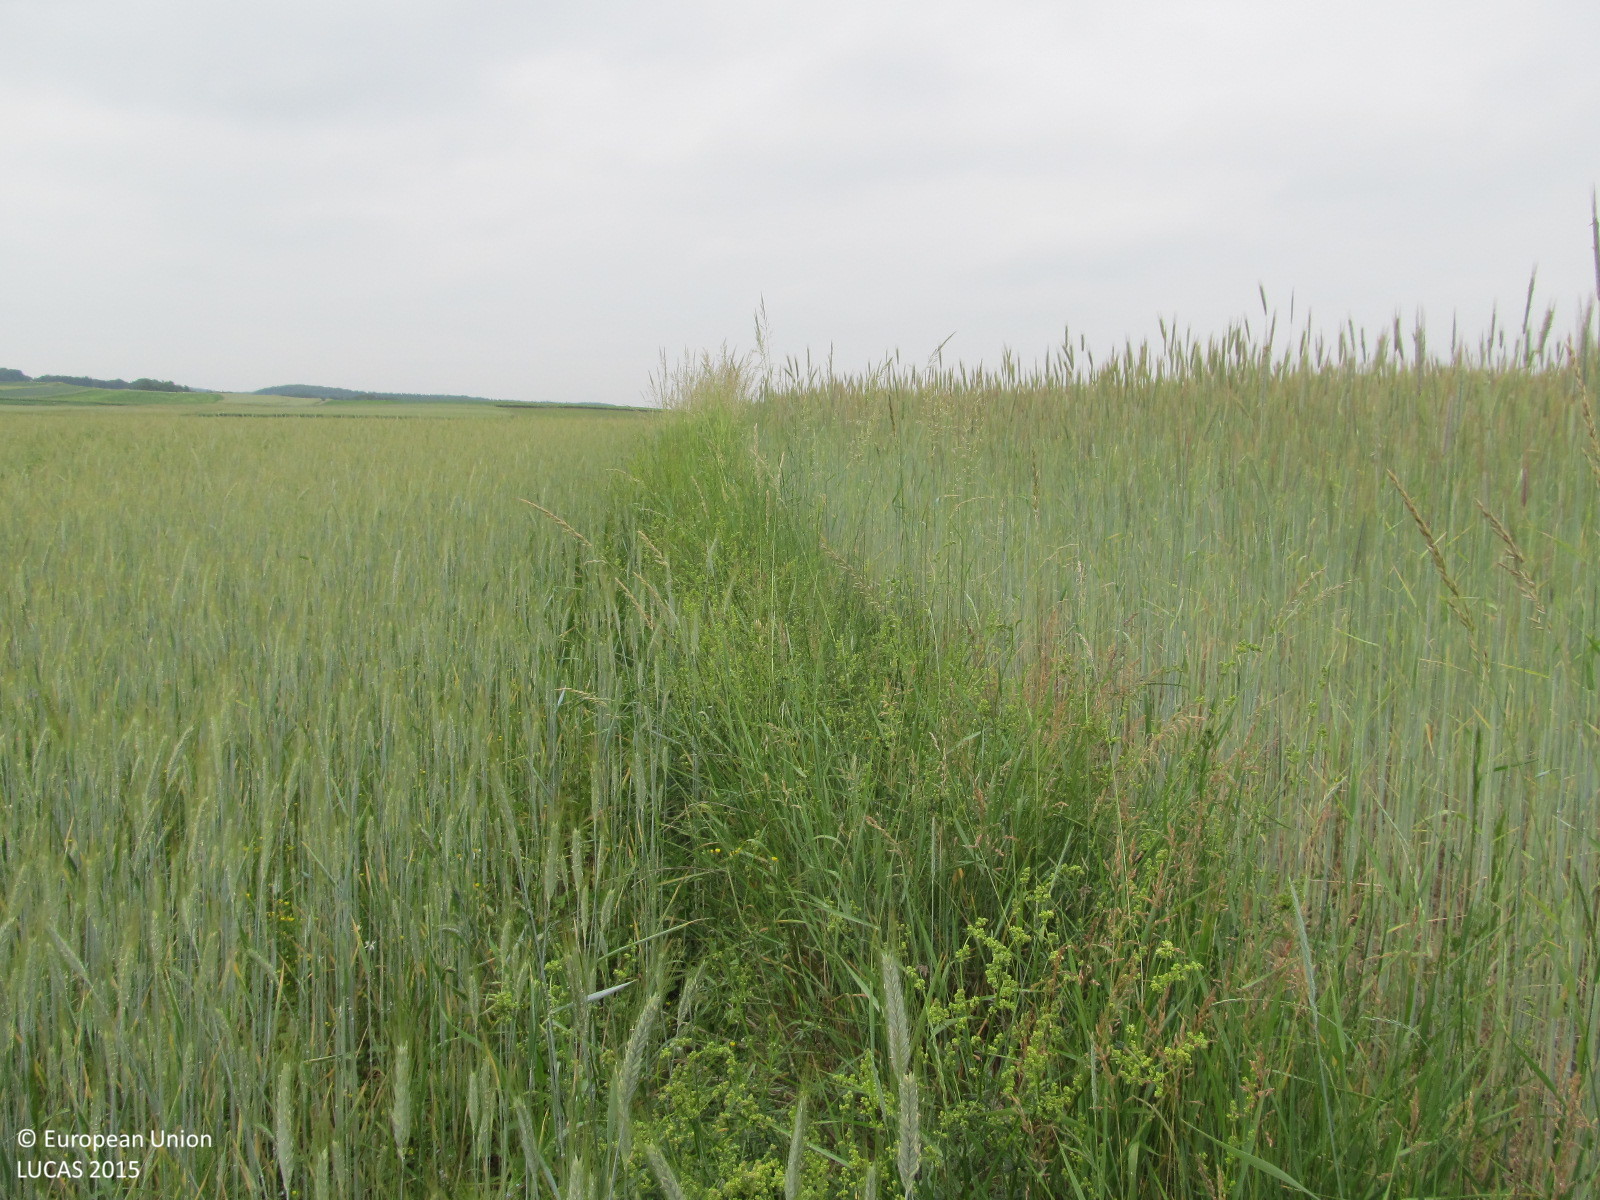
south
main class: Cropland
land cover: Rye
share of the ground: > 75 %
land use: Agriculture (excluding fallow land and kitchen gardens)
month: June
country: AT
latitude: 48.5749
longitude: 15.4649
